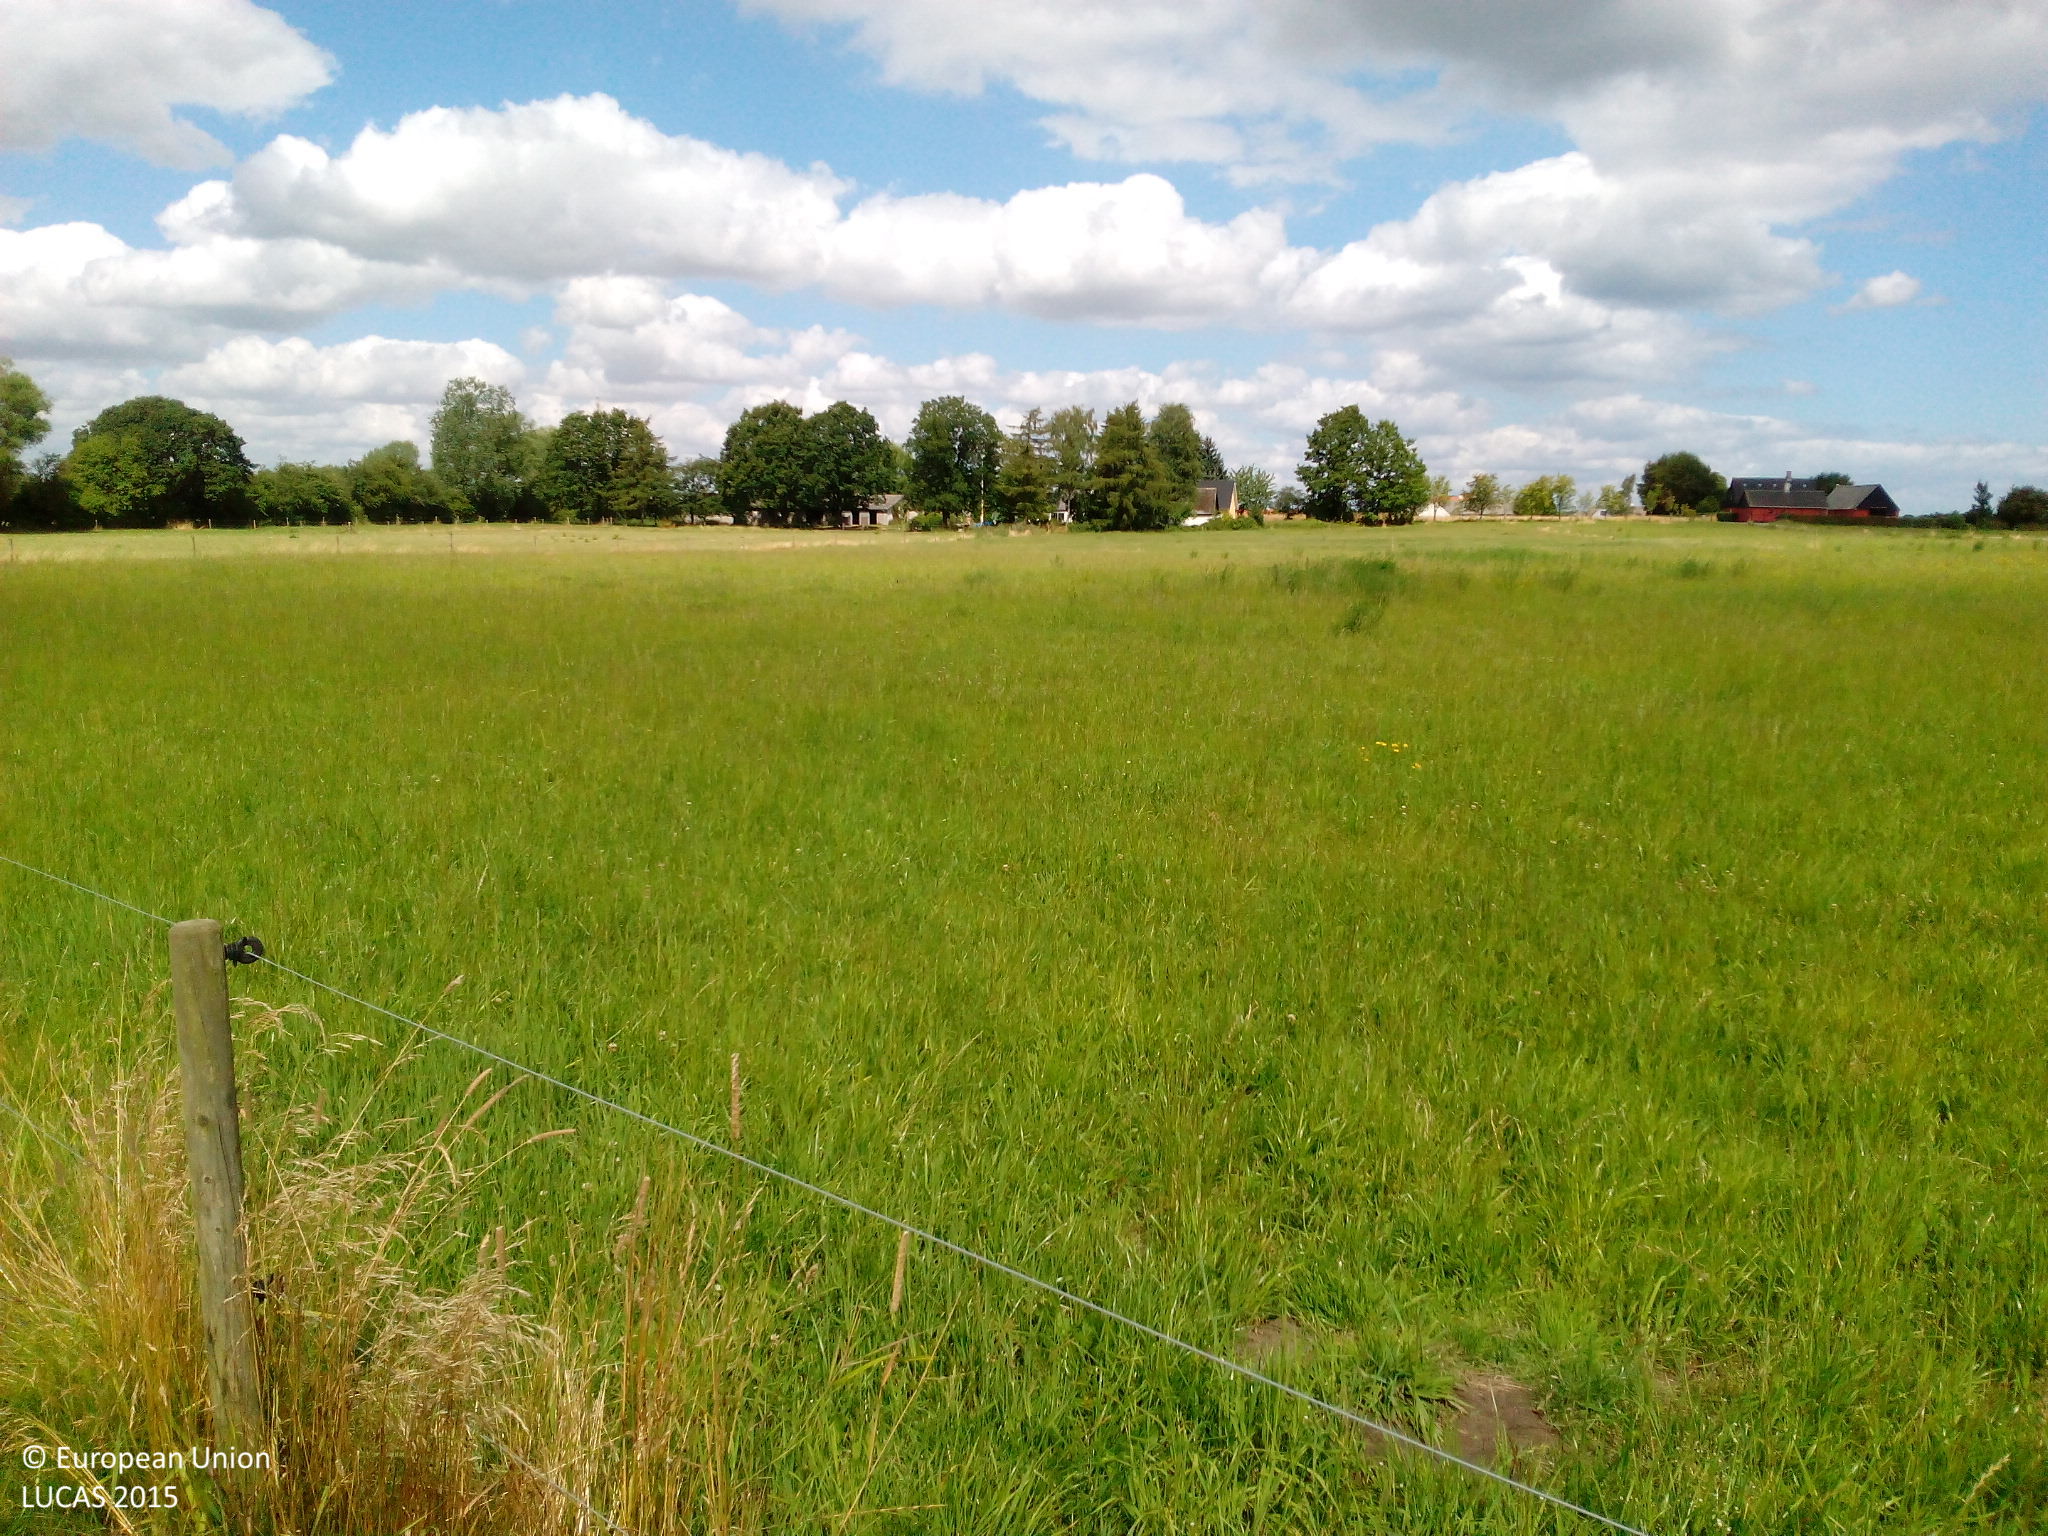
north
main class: Cropland
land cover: Common wheat
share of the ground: > 75 %
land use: Agriculture (excluding fallow land and kitchen gardens)
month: August
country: DK
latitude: 55.3604
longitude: 12.1595
